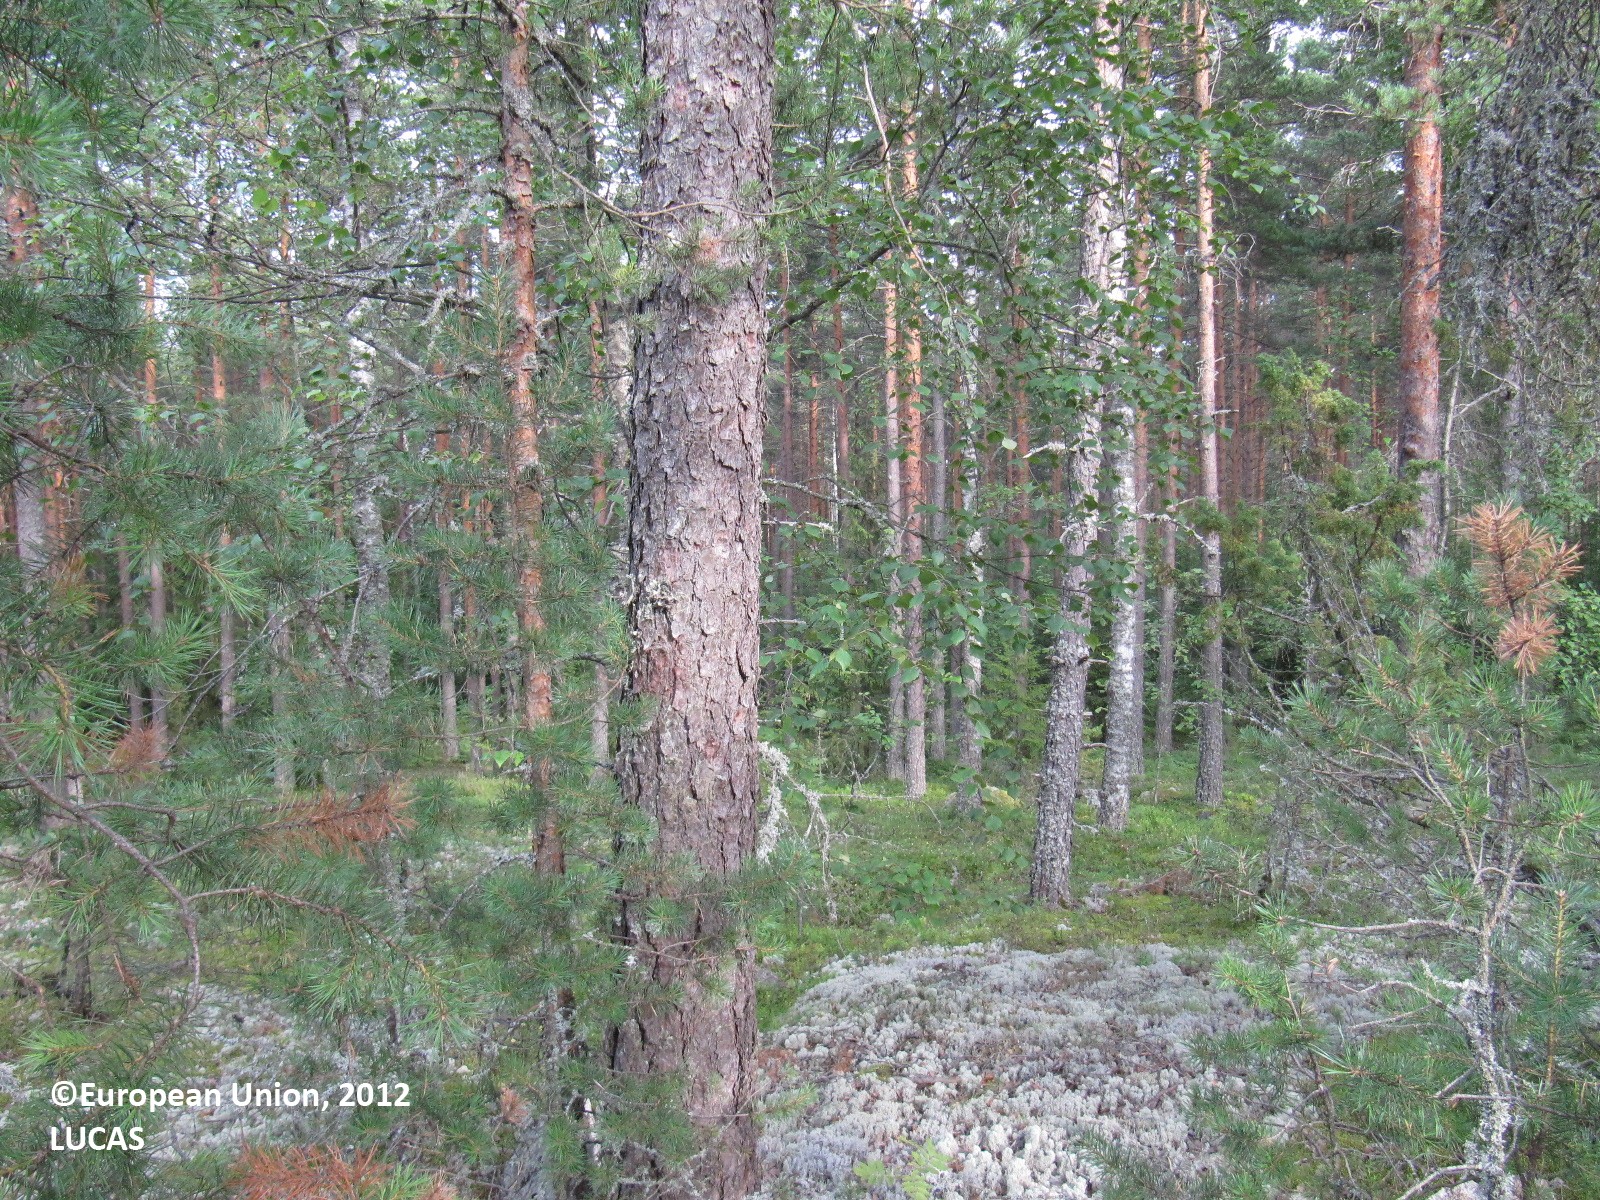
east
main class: Woodland
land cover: Pine dominated coniferous woodland
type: boreal forest
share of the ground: > 75 %
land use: Forestry
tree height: > 5 m
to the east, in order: Pine dominated coniferous woodland; Tracks; Pine dominated mixed woodland; Fences; Grassland with sparse tree/shrub cover; Artificial constructions in urban areas; Grassland with sparse tree/shrub cover
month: August
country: FI
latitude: 60.3516
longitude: 23.1112
